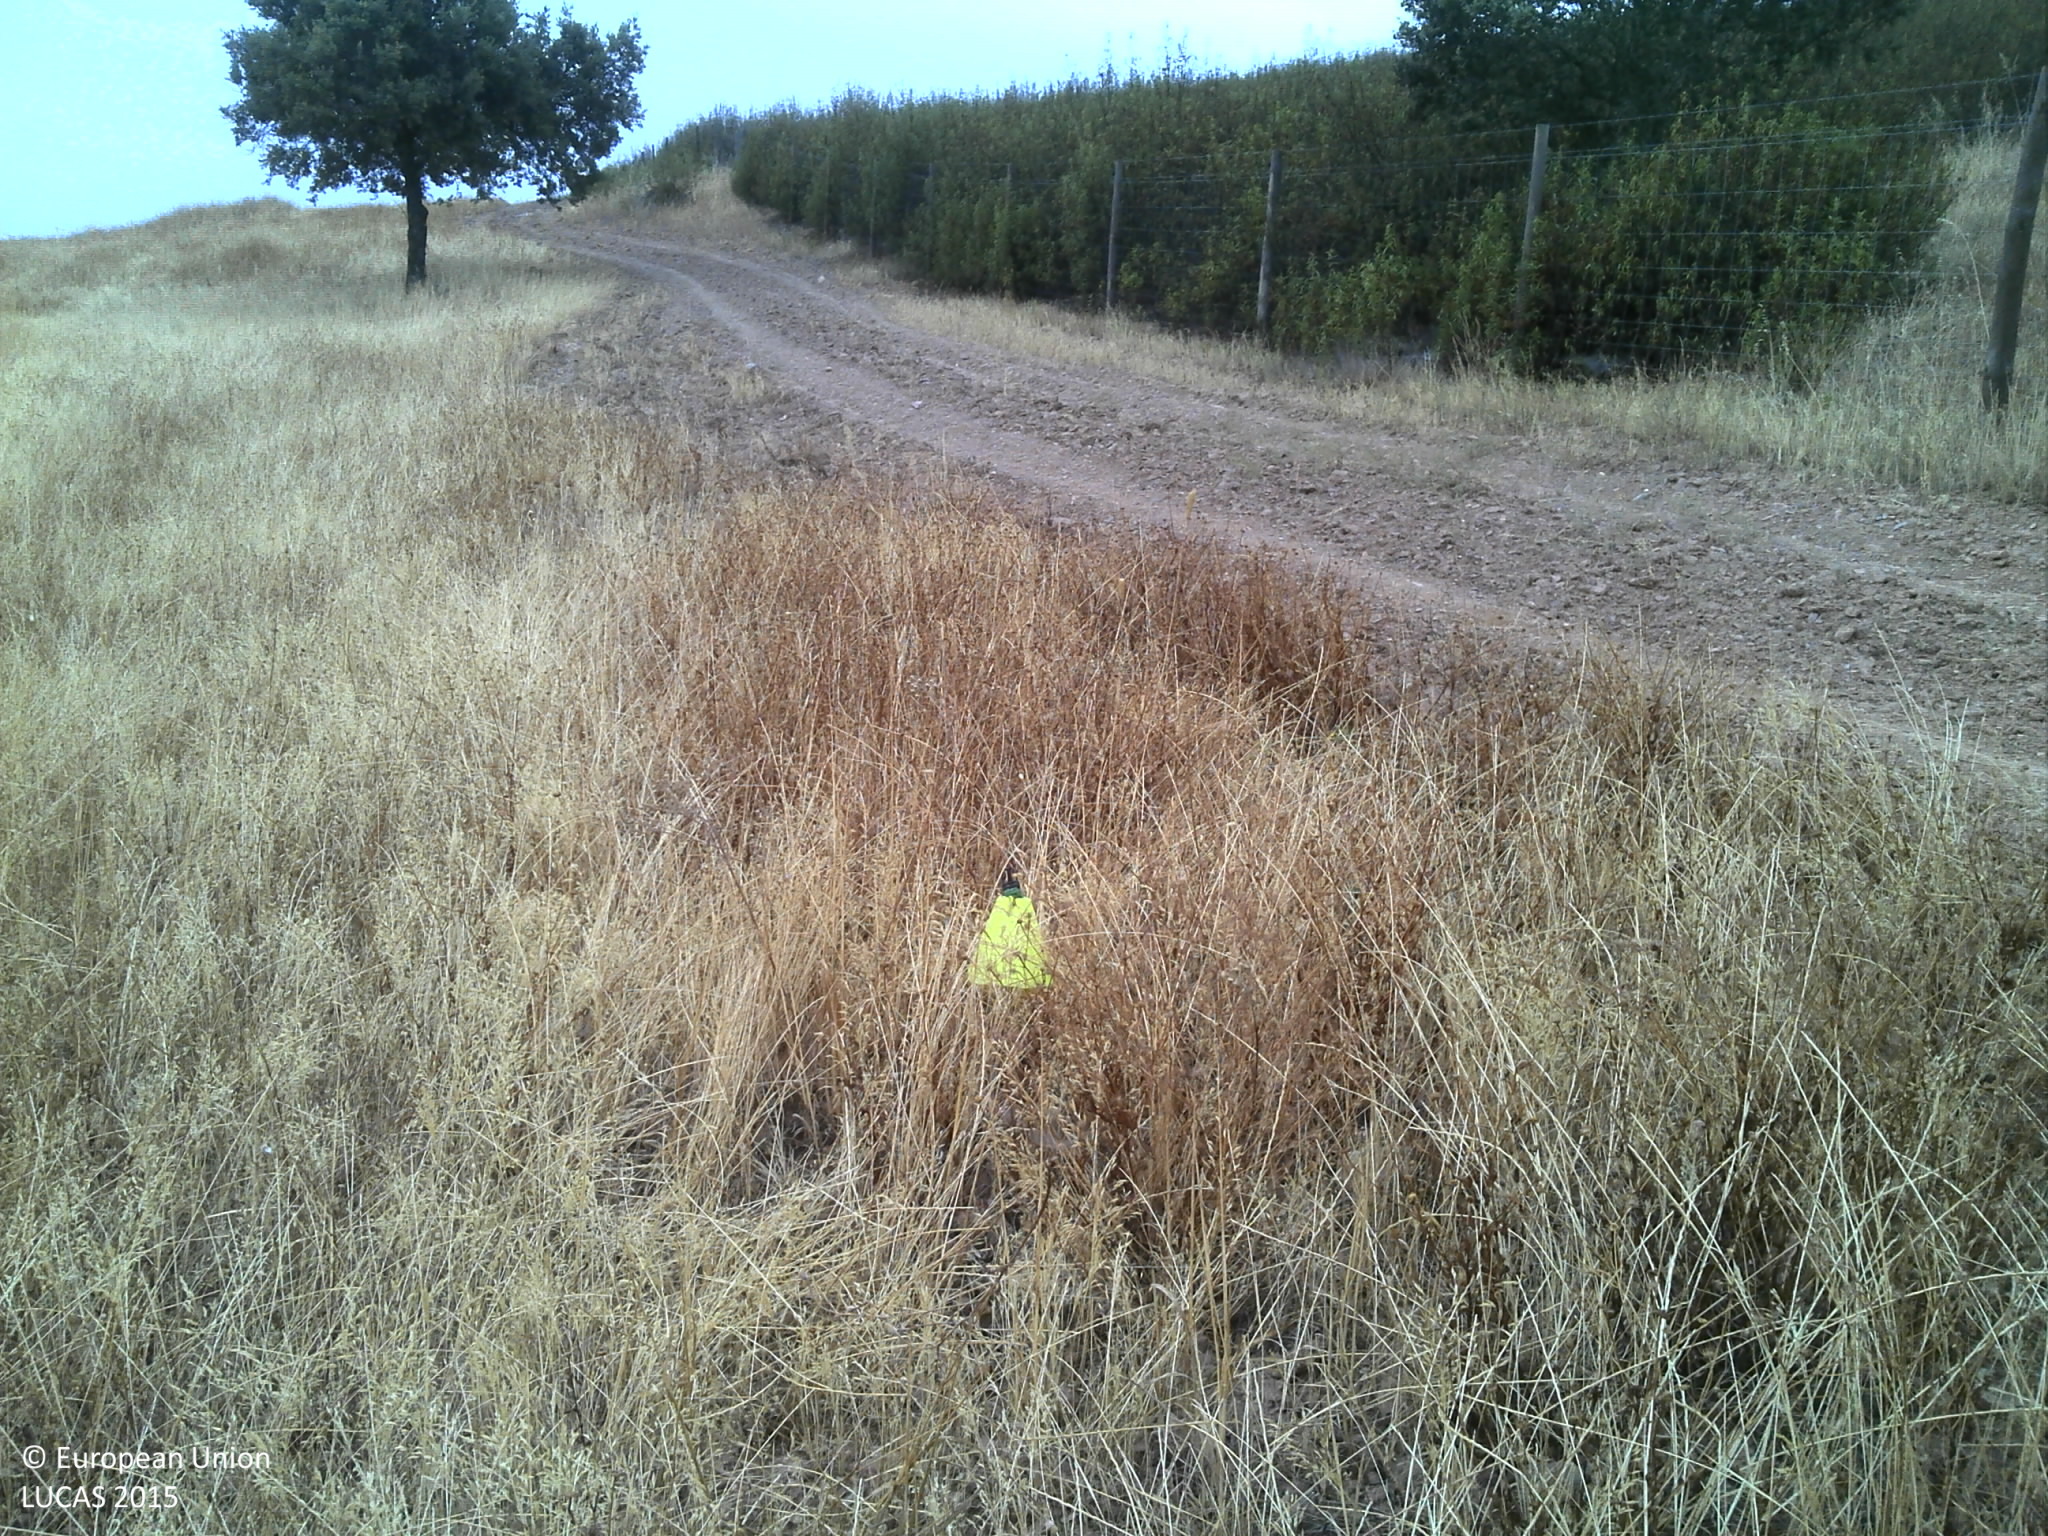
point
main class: Grassland
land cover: Grassland without tree/shrub cover
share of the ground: > 75 %
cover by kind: herbaceous plants 80 %, unconsolidated bare surface 20 %
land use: Agriculture (excluding fallow land and kitchen gardens)
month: July
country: PT
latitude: 38.4747
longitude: -7.4146
